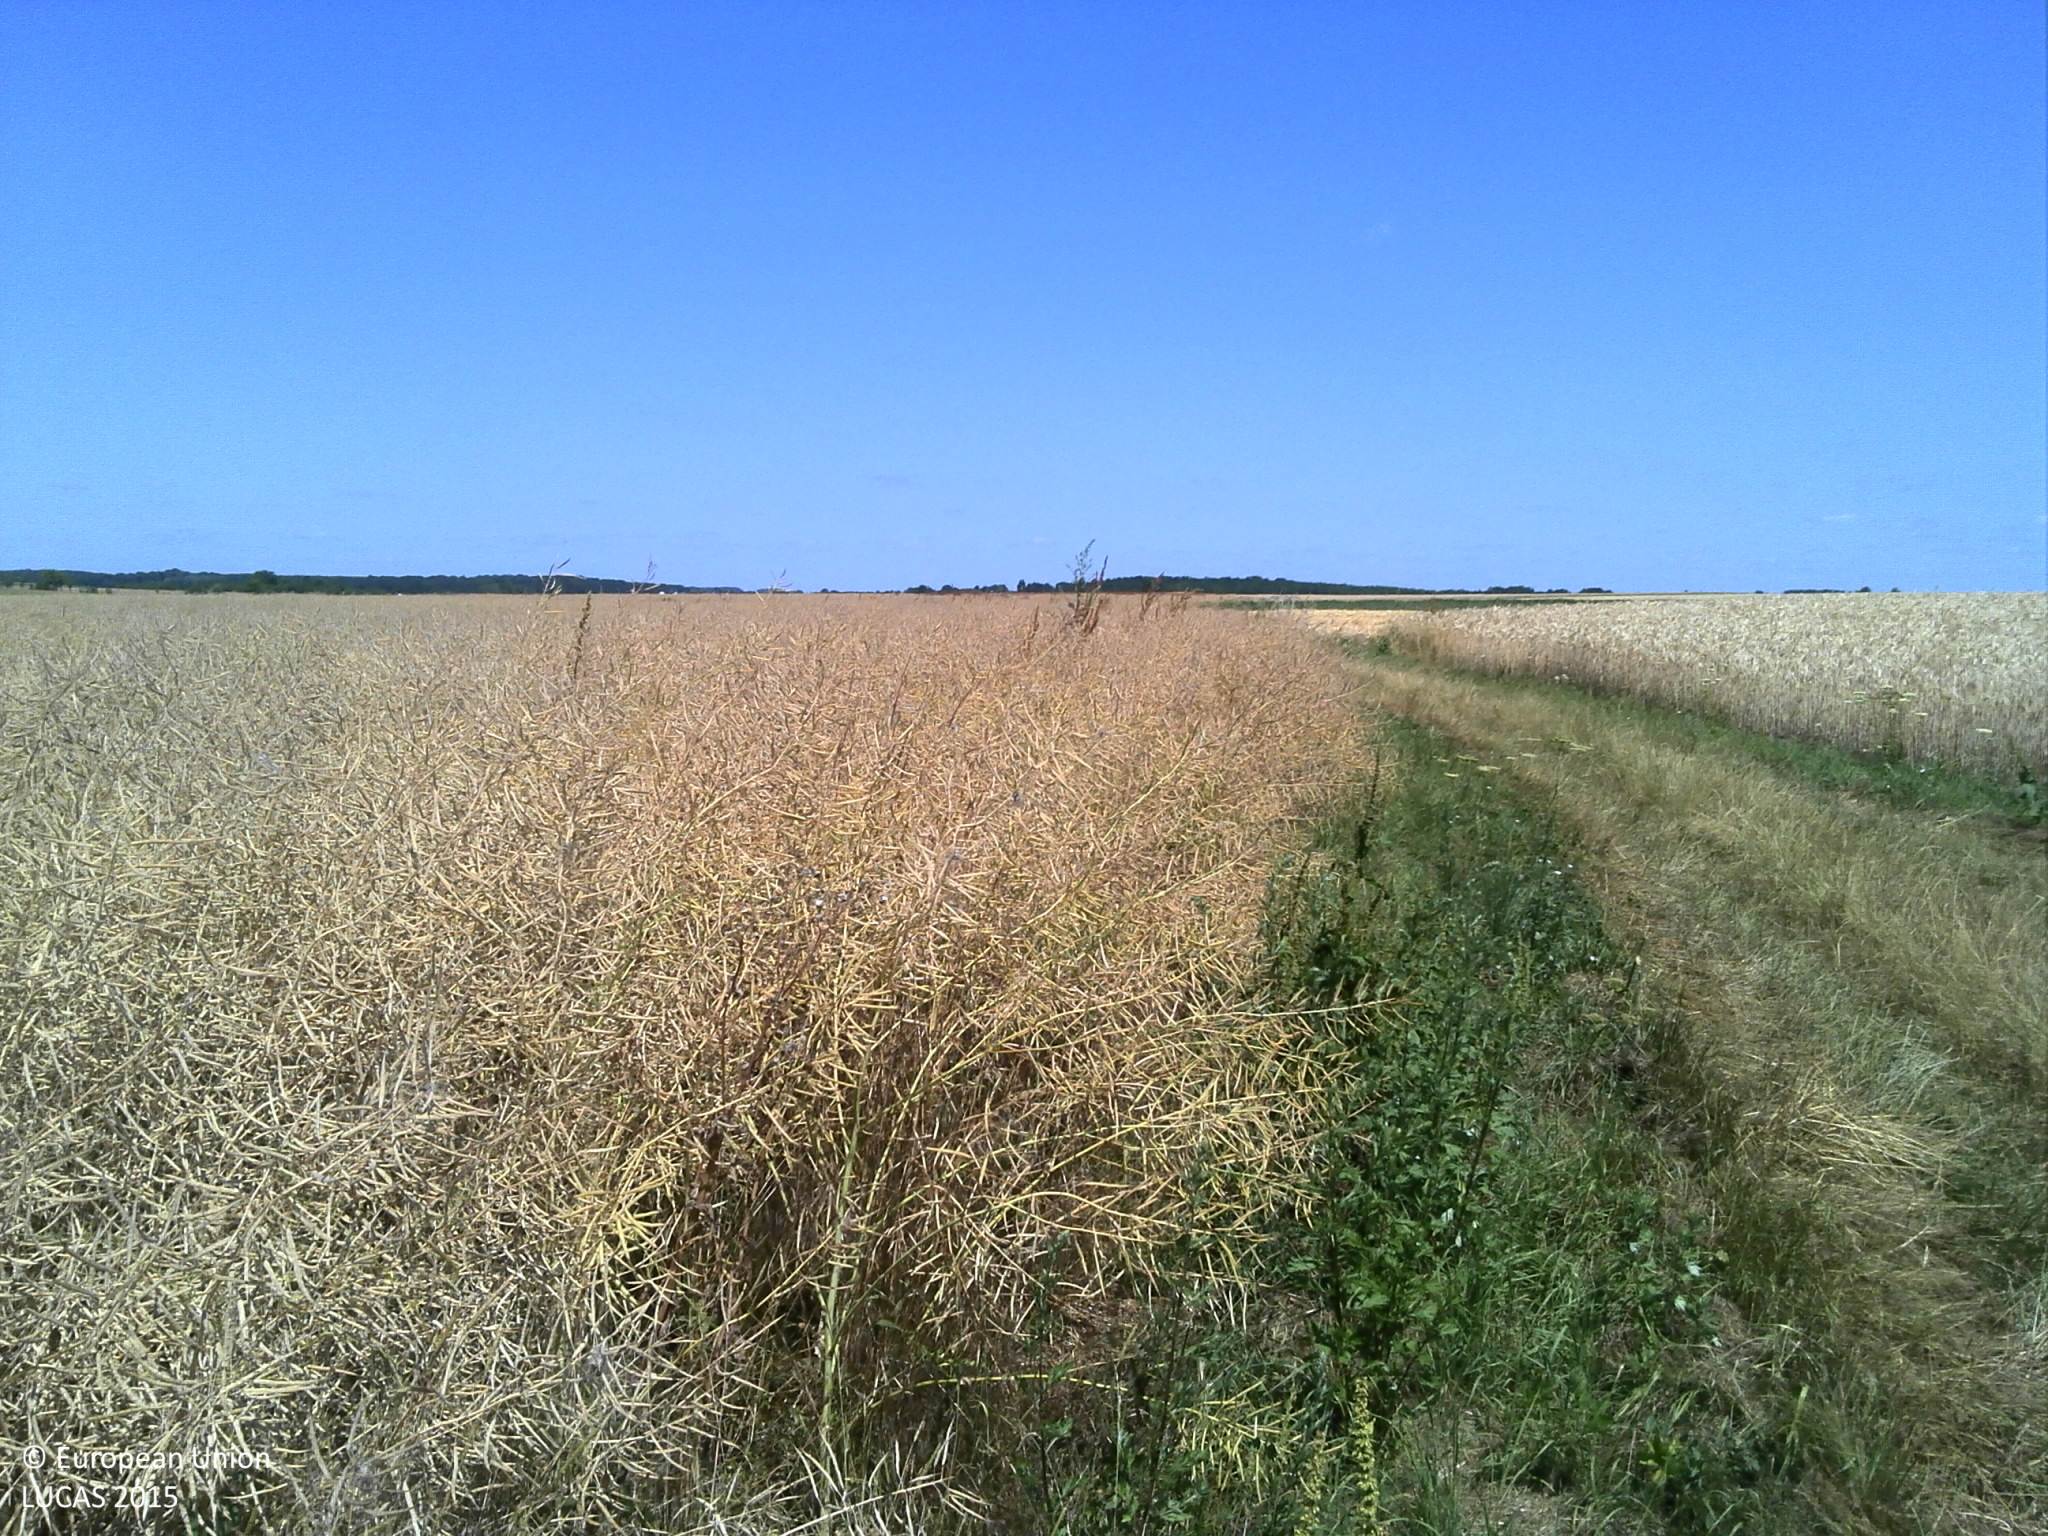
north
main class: Cropland
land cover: Rape and turnip rape
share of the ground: > 75 %
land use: Agriculture (excluding fallow land and kitchen gardens)
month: July
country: FR
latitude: 49.4730
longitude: 6.2045
